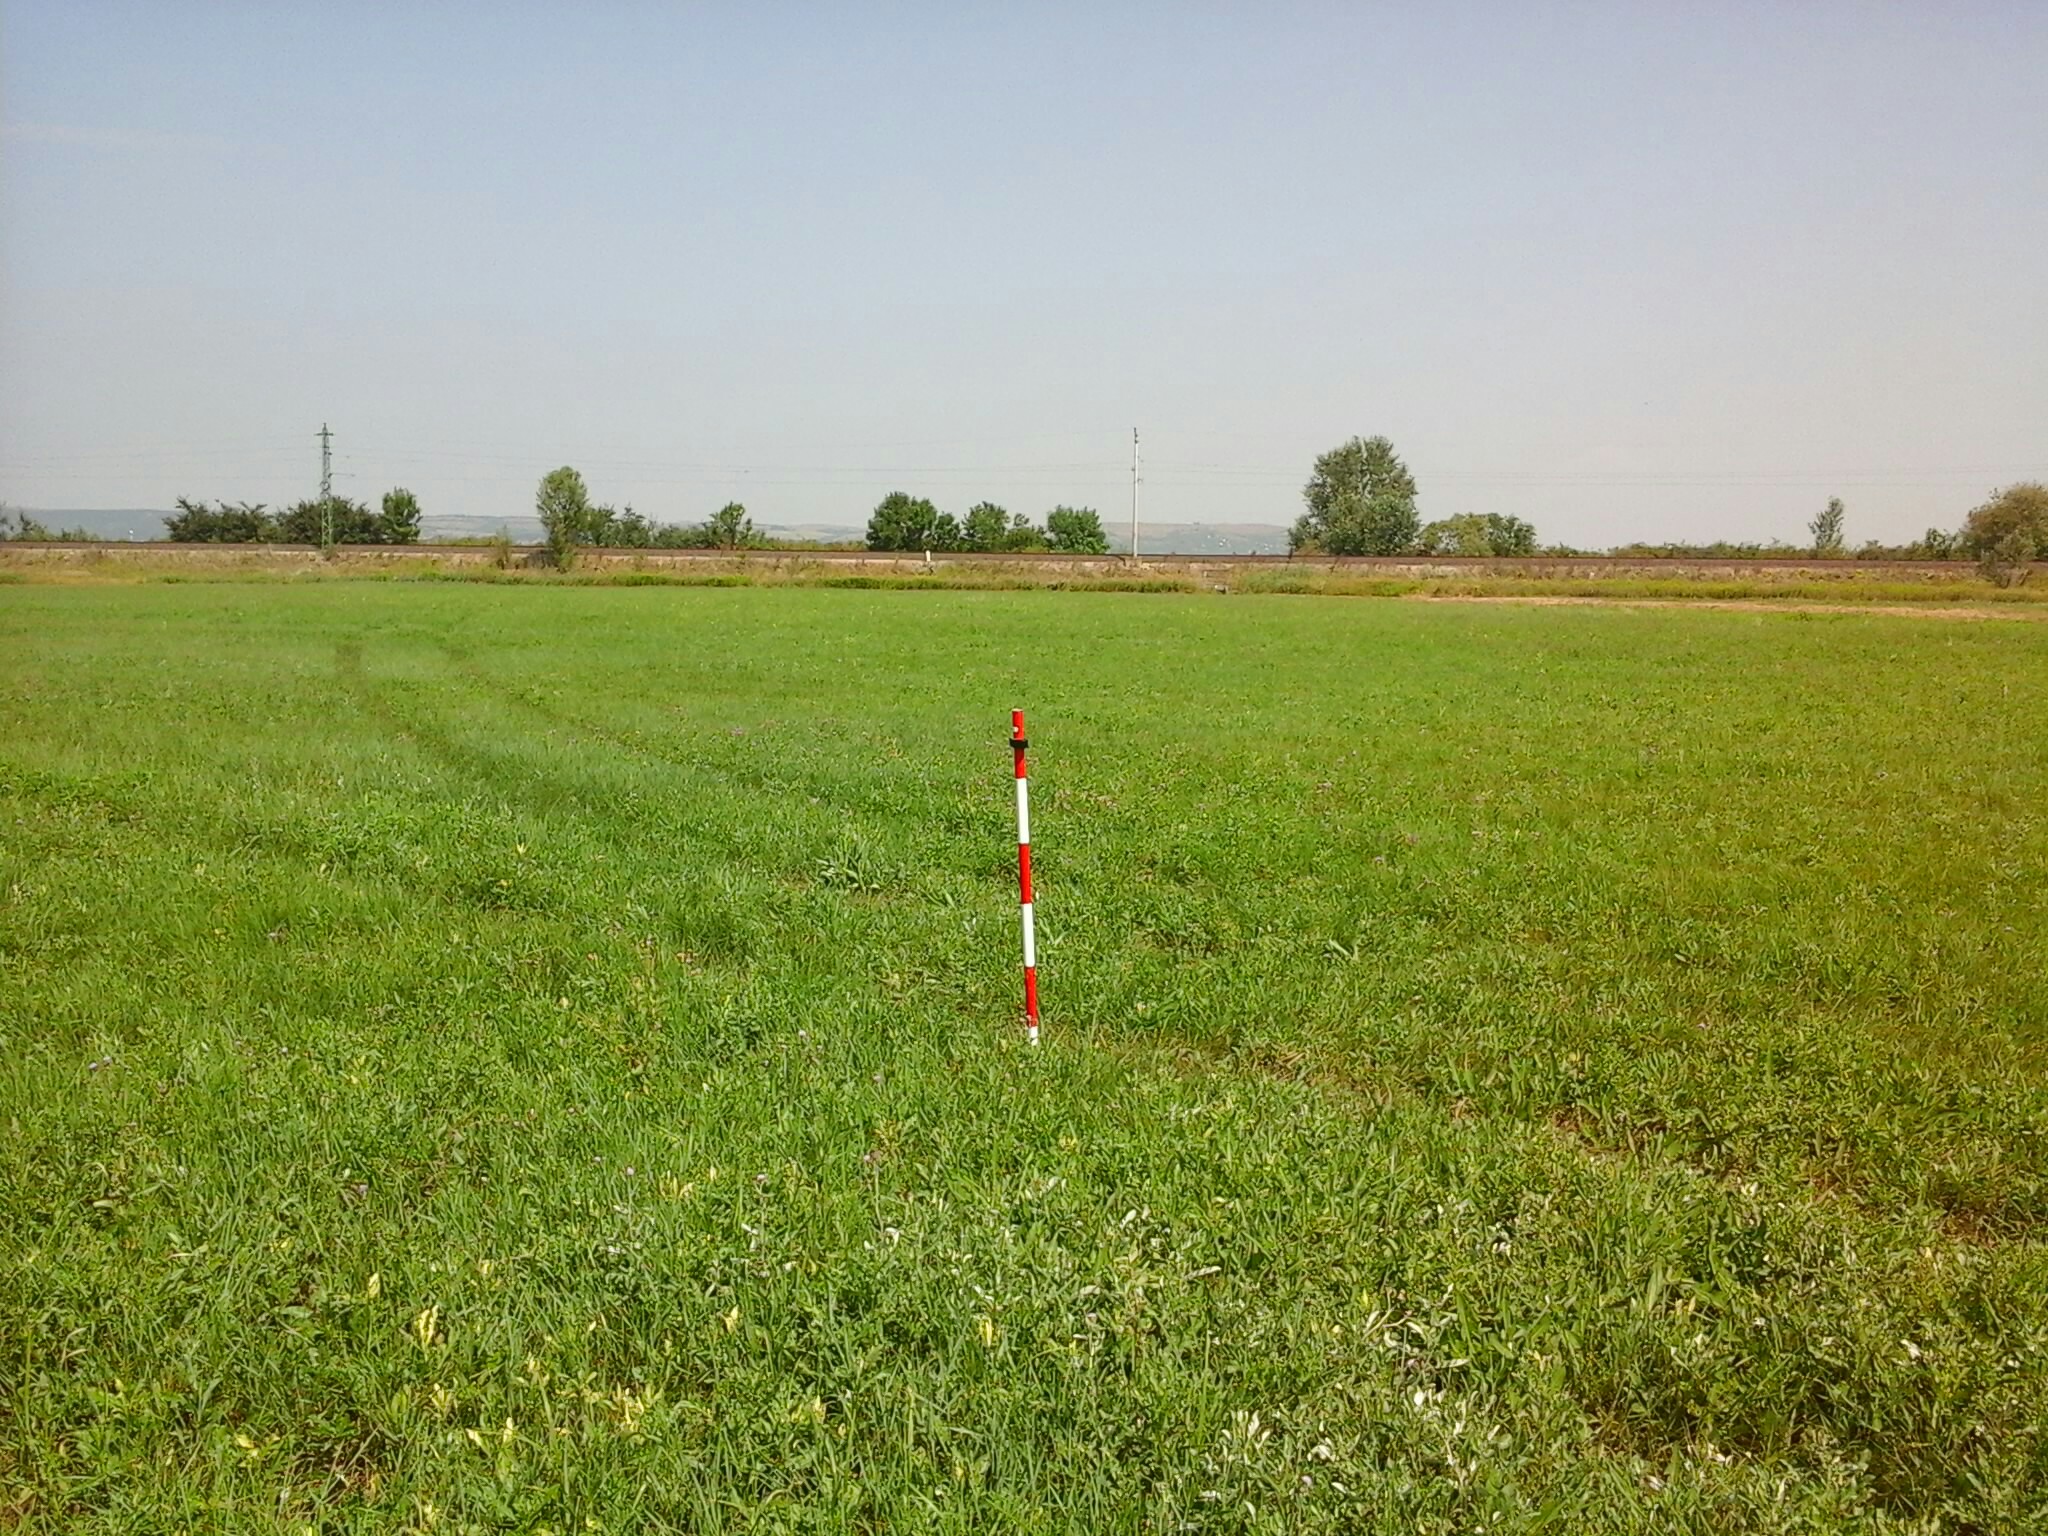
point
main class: Grassland
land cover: Grassland without tree/shrub cover
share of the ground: > 75 %
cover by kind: herbaceous plants 100 %
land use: Agriculture (excluding fallow land and kitchen gardens)
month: August
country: HU
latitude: 47.1697
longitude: 18.2833
